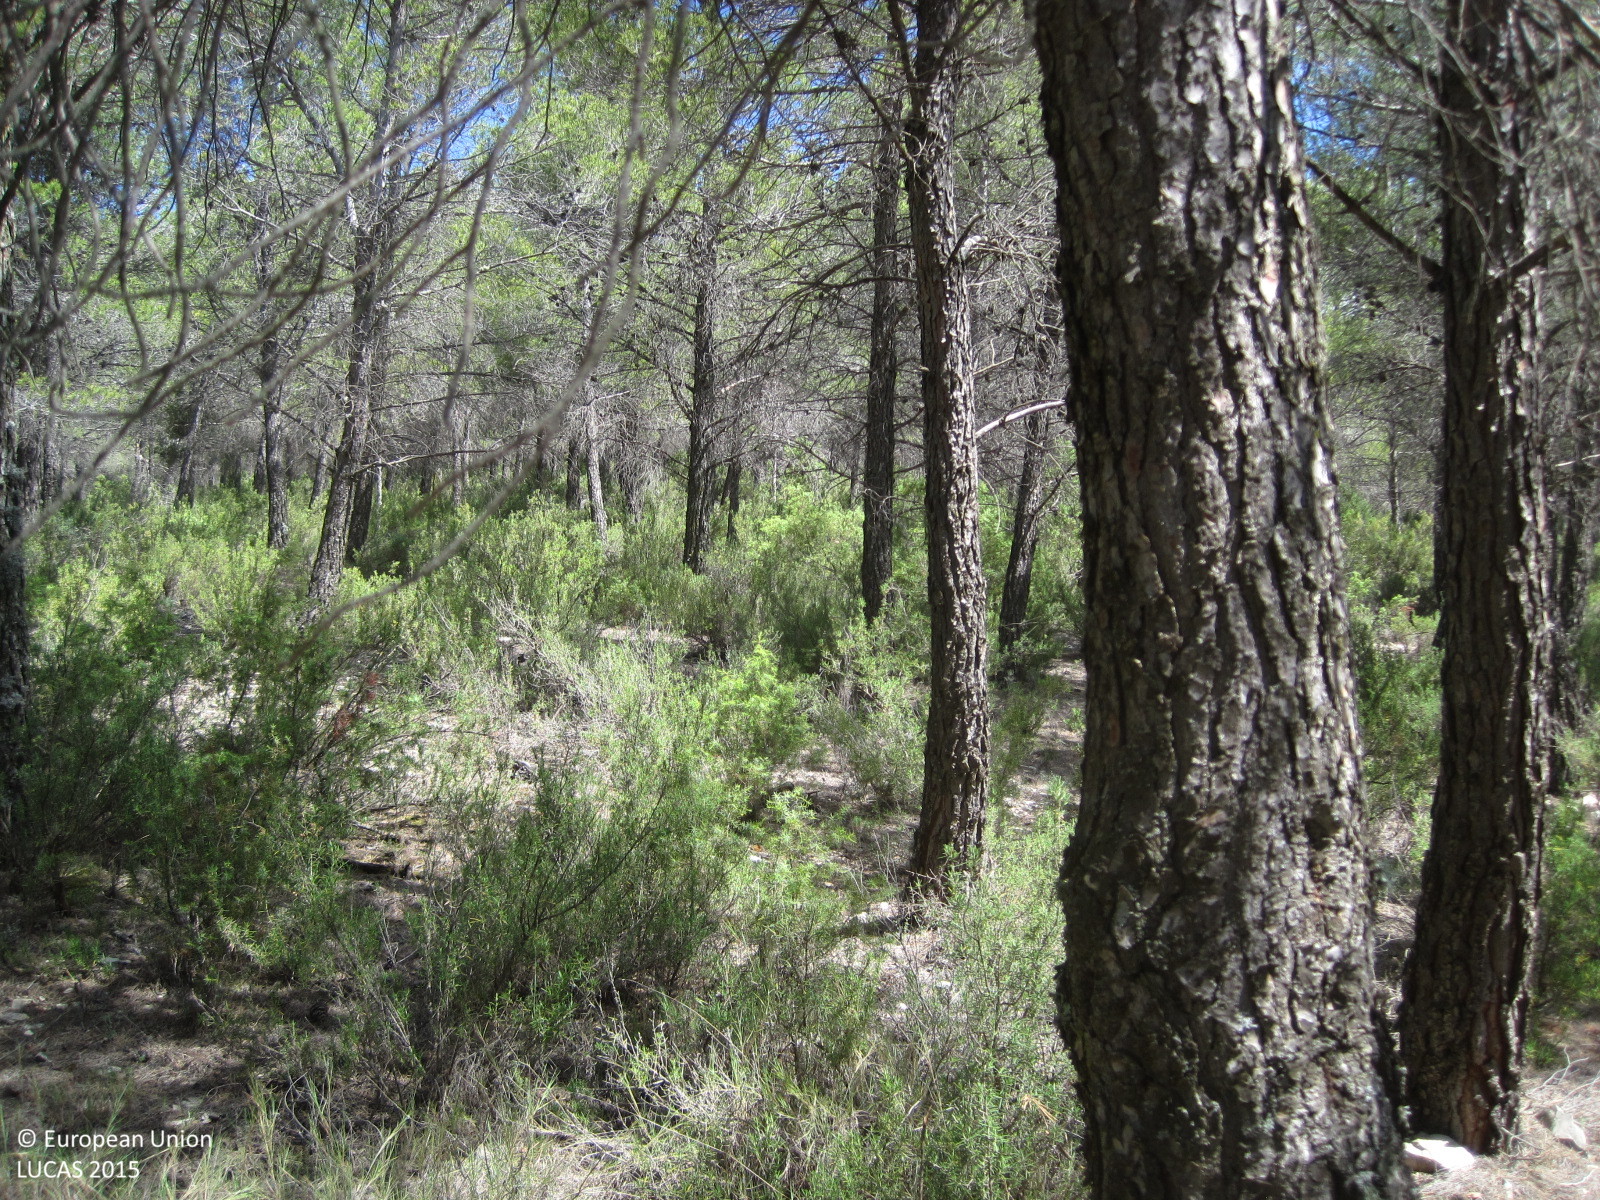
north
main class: Woodland
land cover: Pine dominated coniferous woodland
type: coniferous forest of the mediterranean region
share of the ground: > 75 %
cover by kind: coniferous forest trees 80 %, shrubs 10 %, herbaceous plants 10 %
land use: Forestry
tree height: > 5 m
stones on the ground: 25 - 50 %
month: June
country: ES
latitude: 39.8935
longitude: -0.9162
